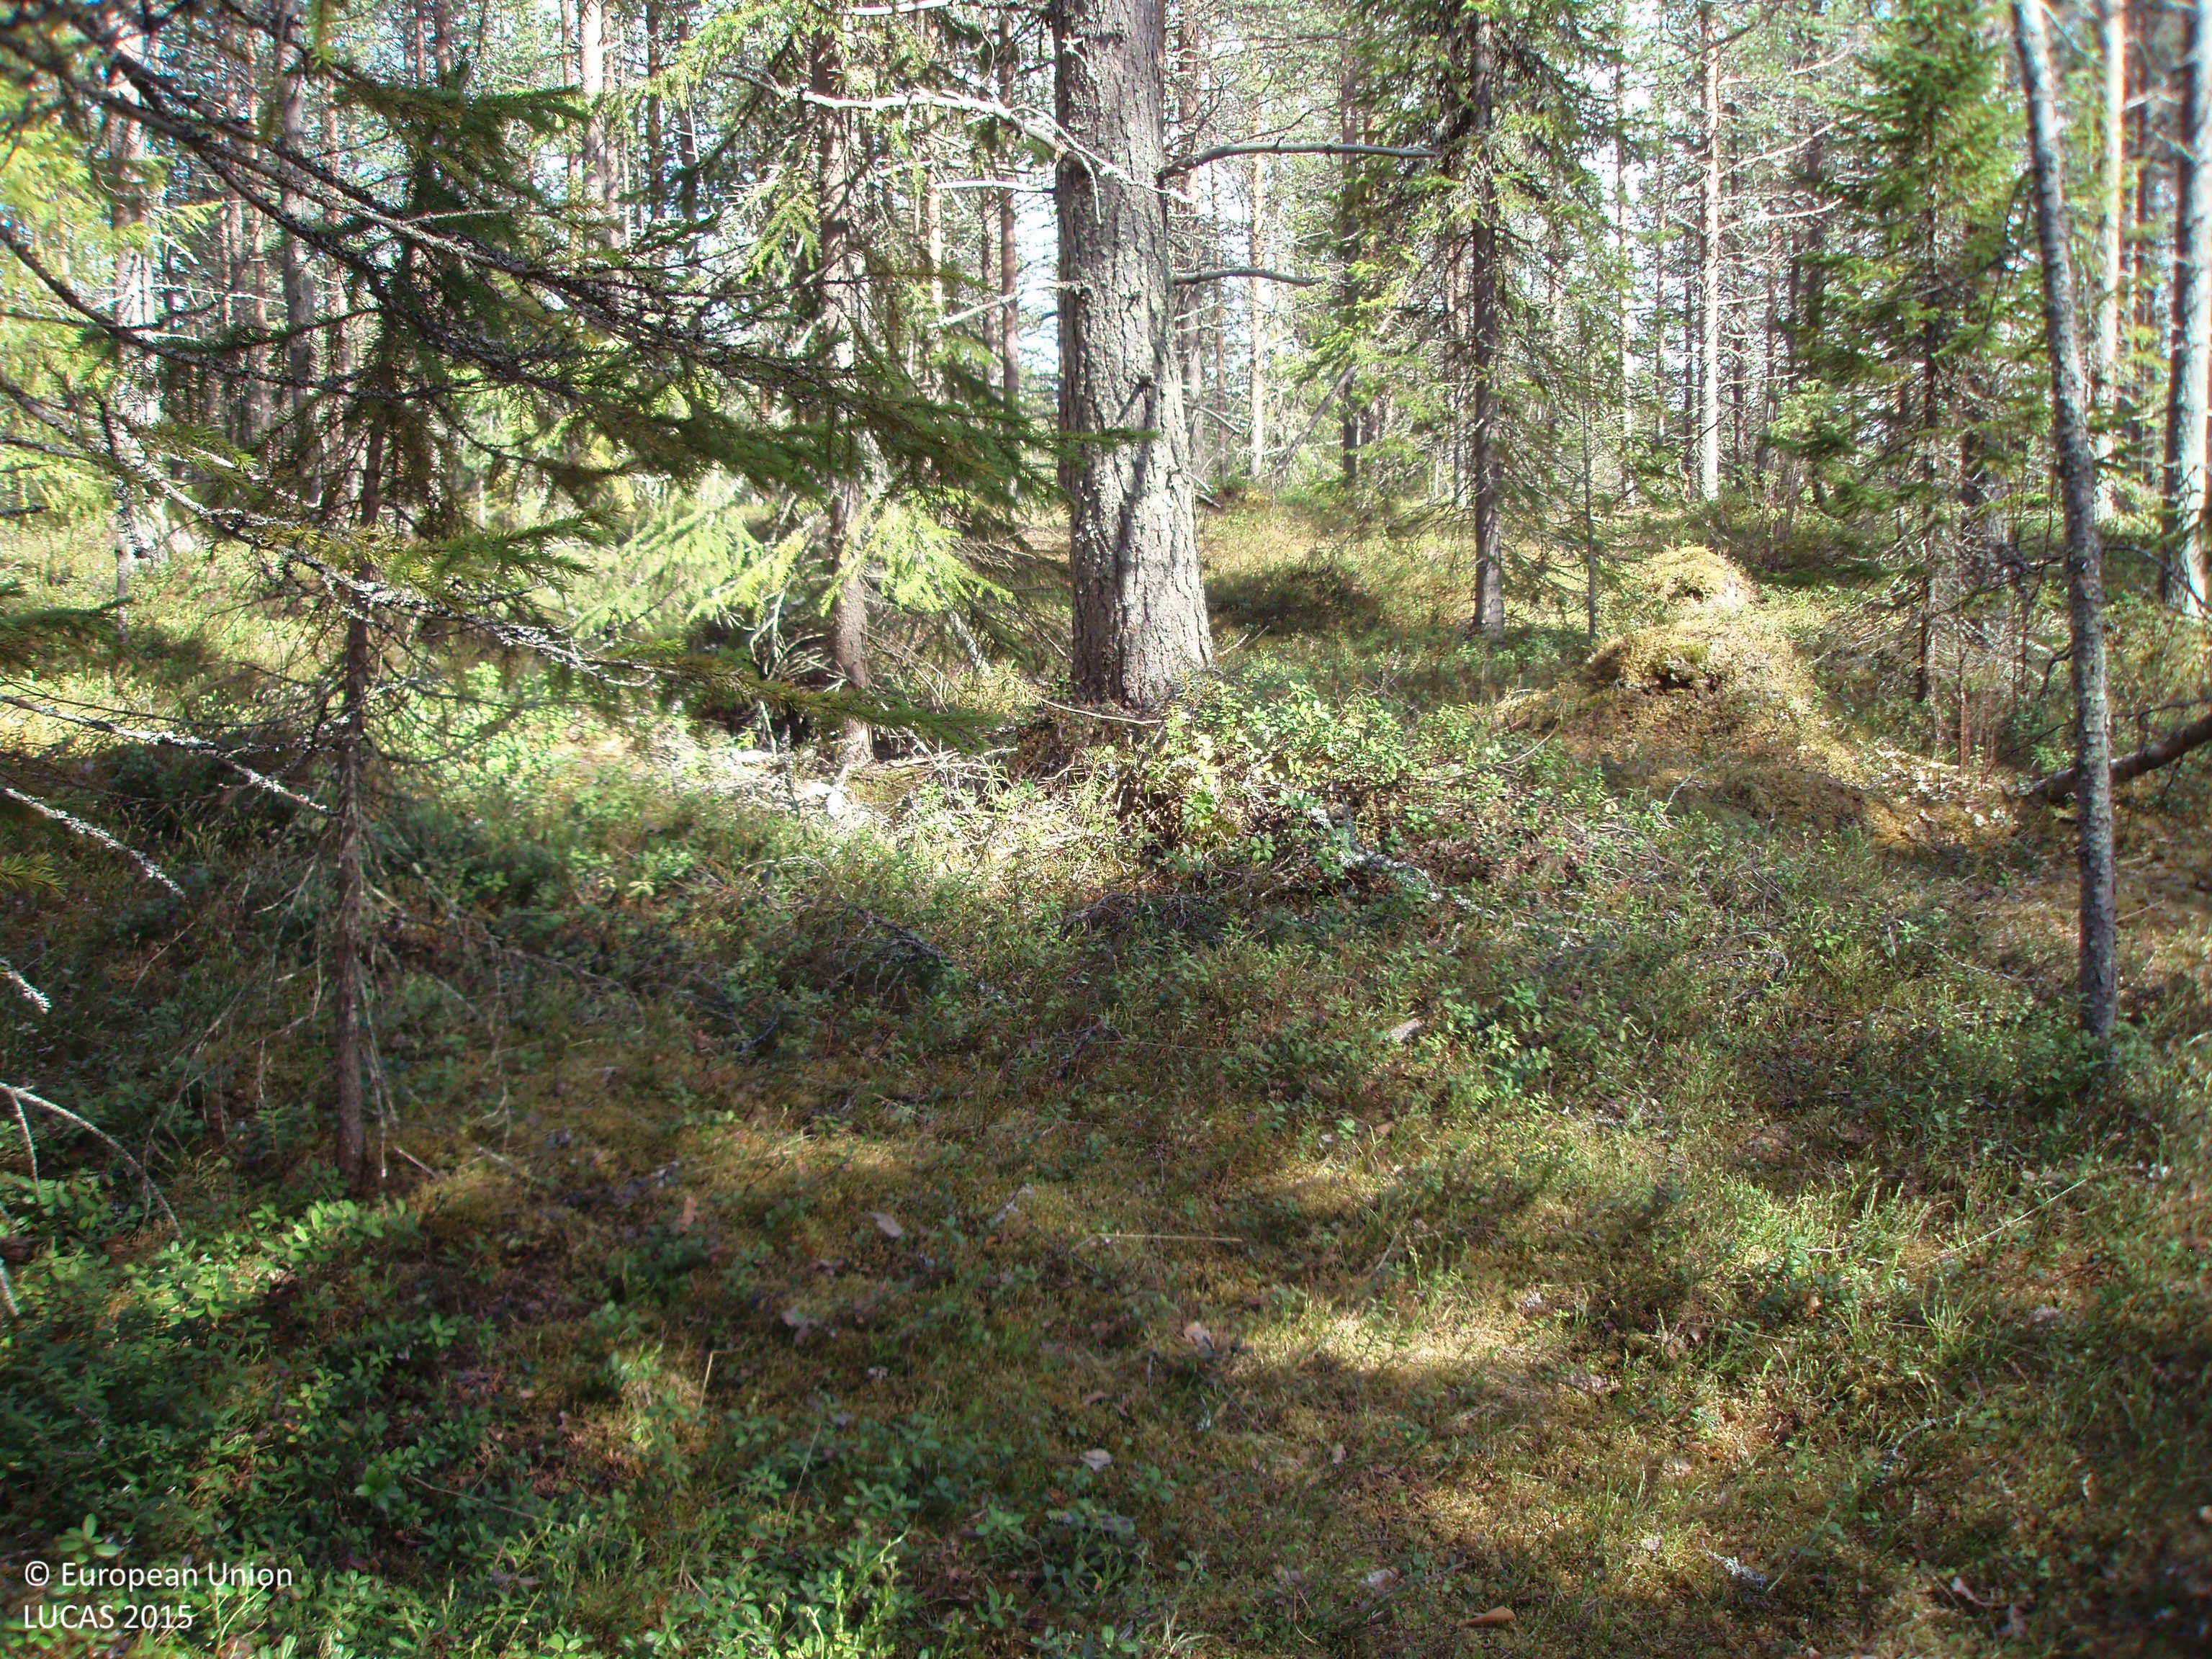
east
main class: Woodland
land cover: Pine dominated coniferous woodland
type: boreal forest
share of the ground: > 75 %
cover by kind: coniferous forest trees 75 %, shrubs 20 %, lichens and mosses 5 %
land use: Forestry
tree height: > 5 m
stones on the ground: < 10 %
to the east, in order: Pine dominated coniferous woodland; Tracks; Other mixed woodland; Pine dominated coniferous woodland
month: June
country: FI
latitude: 66.7270
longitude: 26.9934
